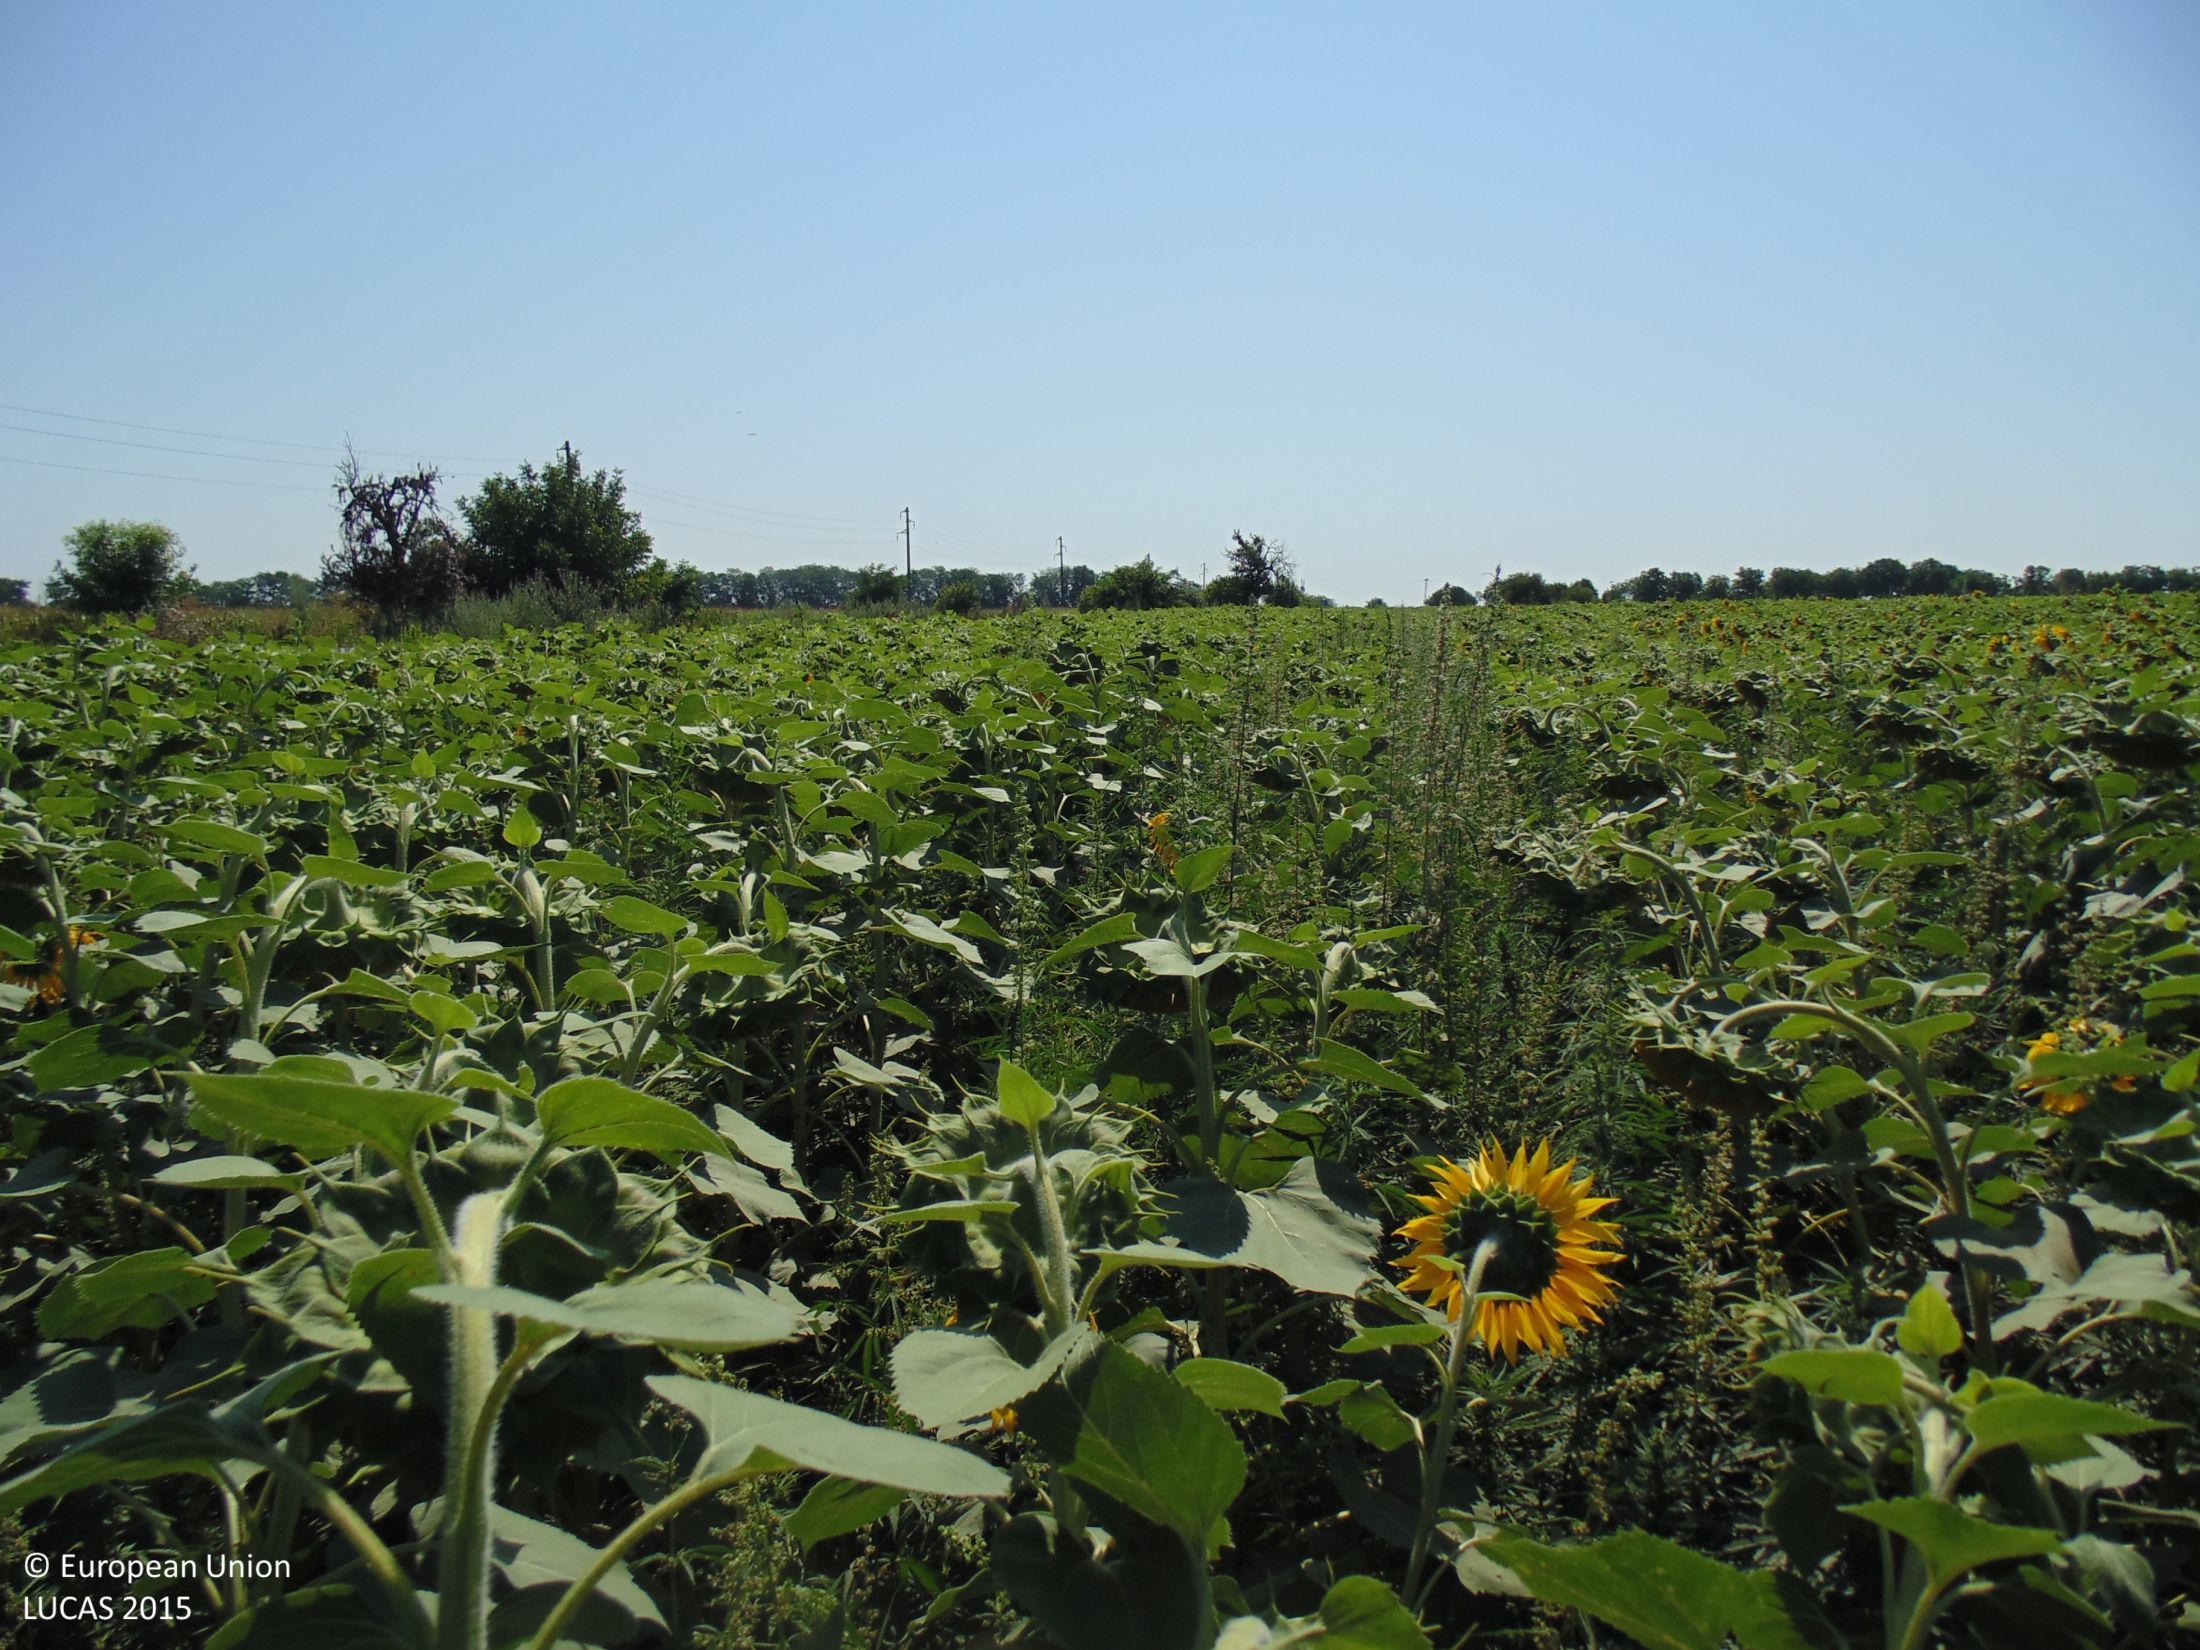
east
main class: Cropland
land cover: Sunflower
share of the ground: > 75 %
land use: Agriculture (excluding fallow land and kitchen gardens)
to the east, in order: Sunflower; Grassland without tree/shrub cover; Ditches and canals; Grass margins; Paved roads, cycling and walking lanes; Grass margins; Lines of trees; Grass margins; Maize; Electric lines; Maize
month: July
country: BG
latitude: 43.6077
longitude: 27.6939
